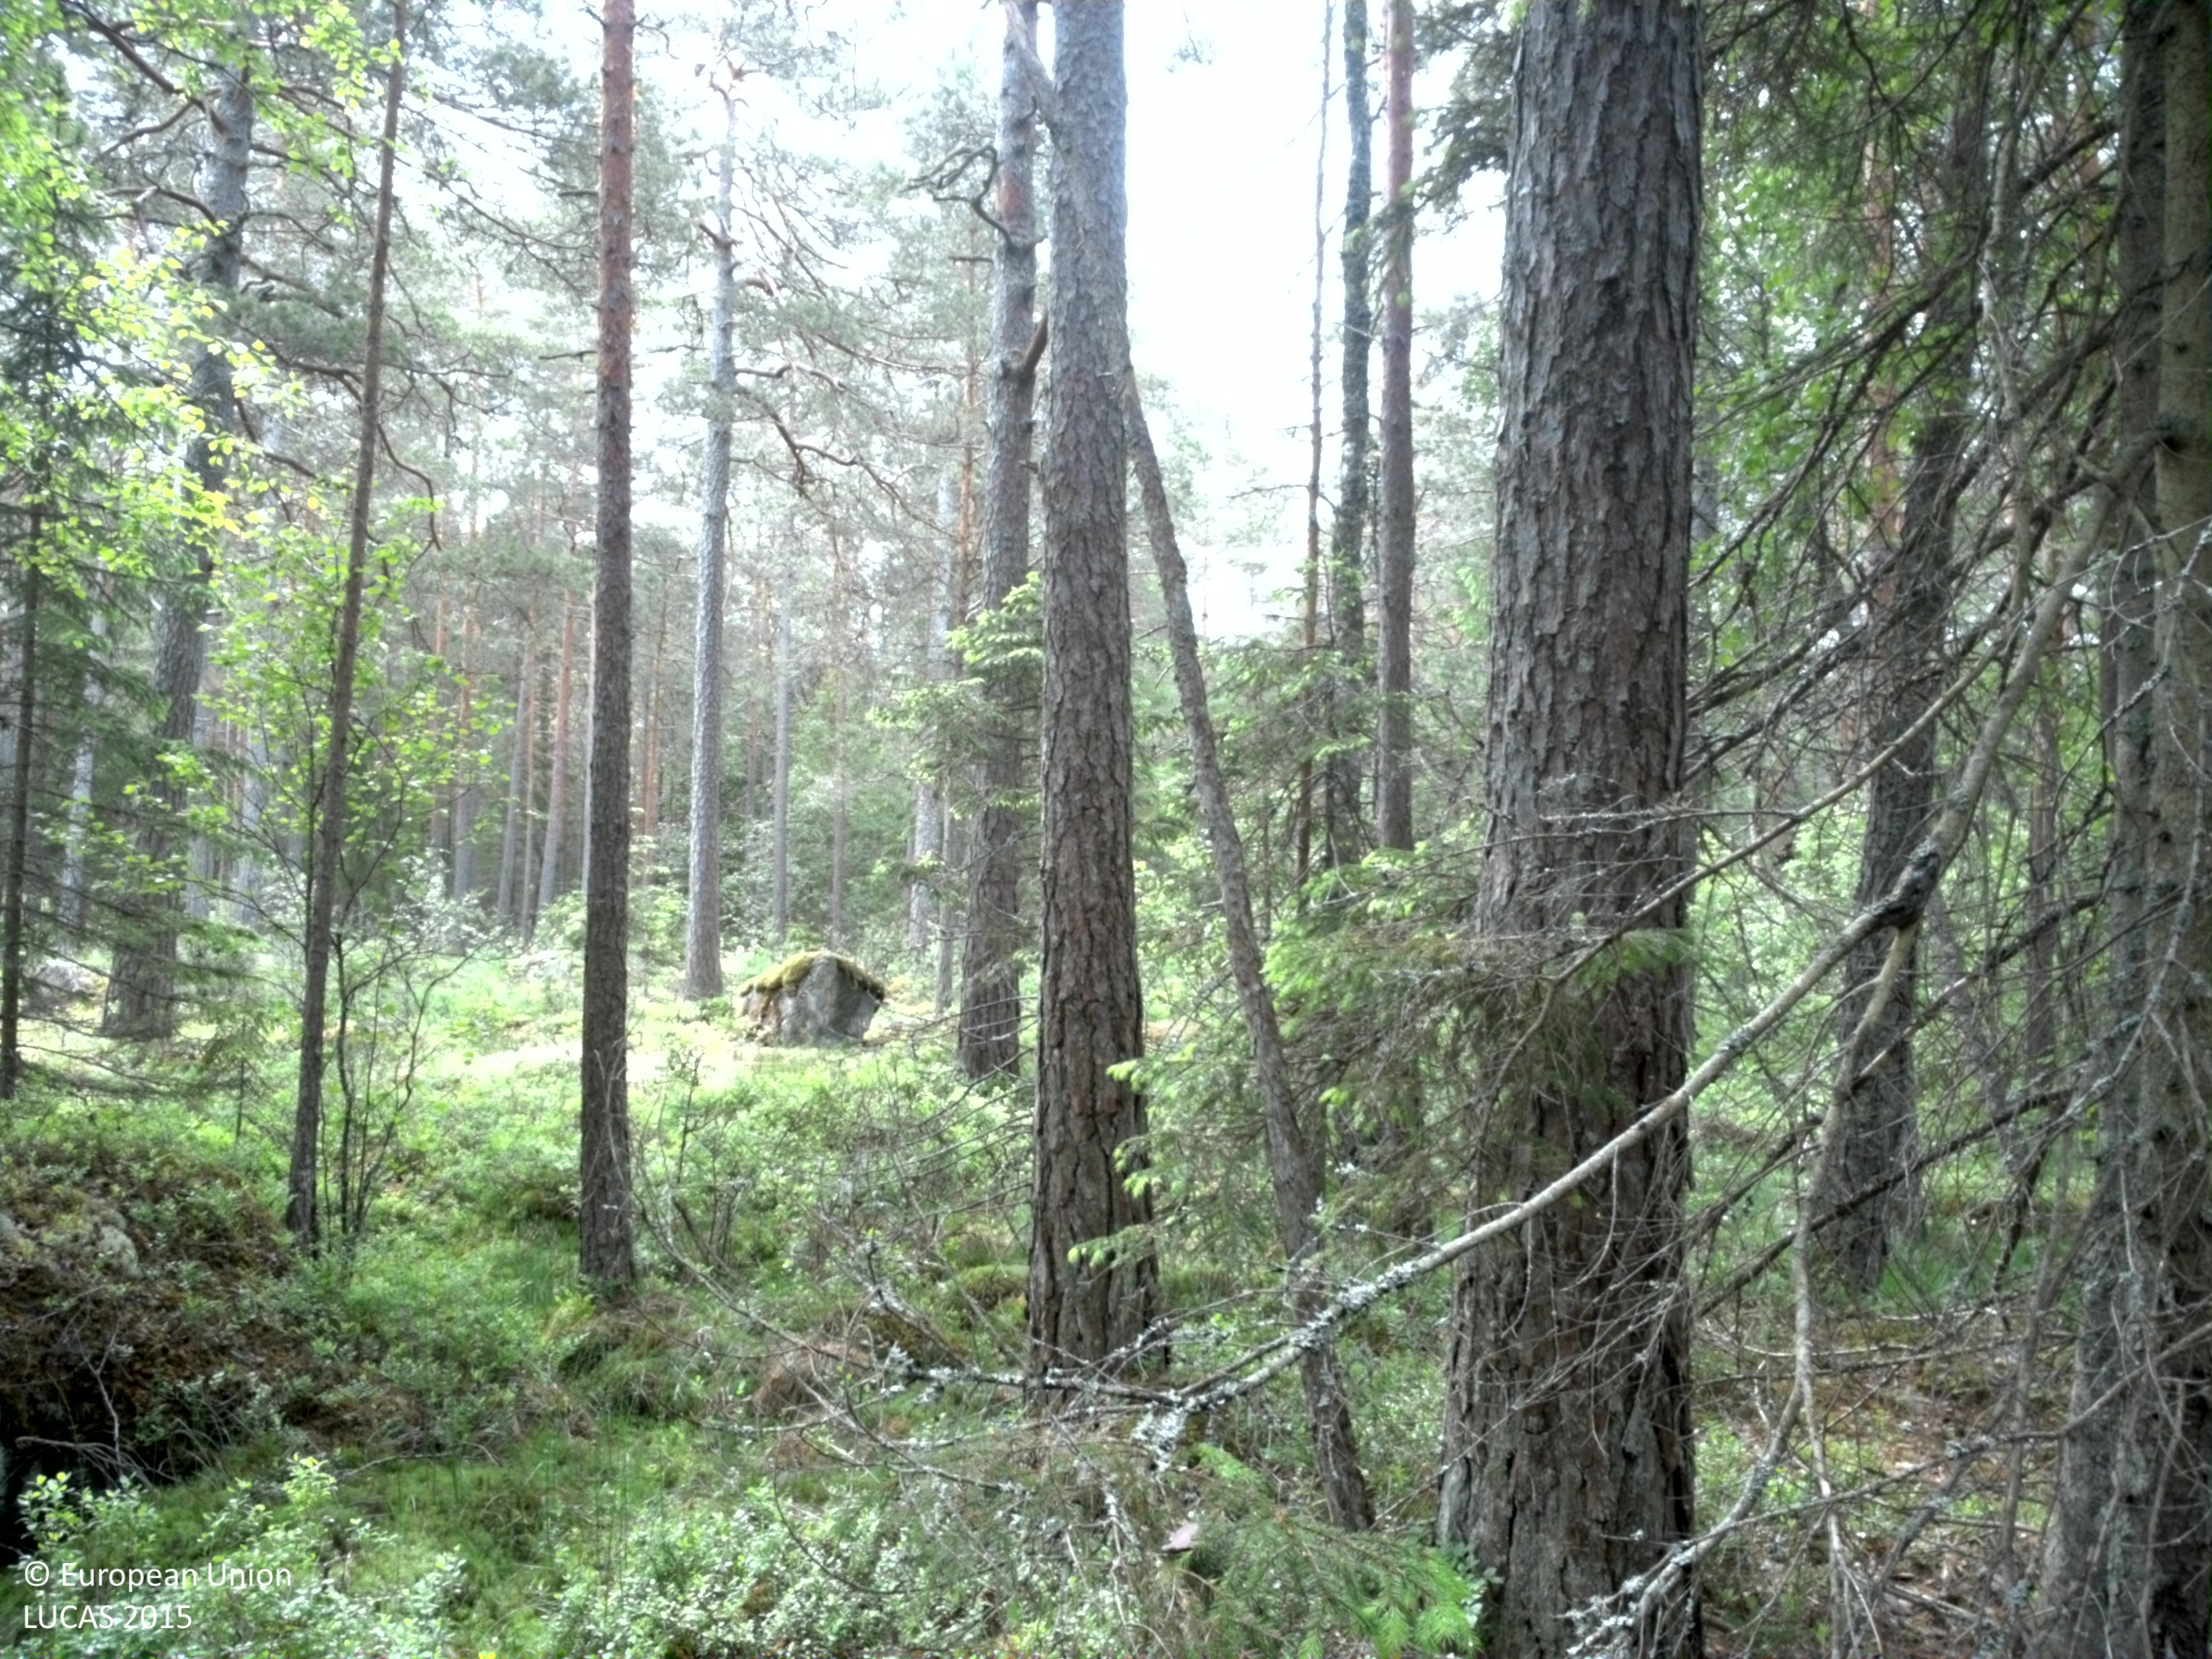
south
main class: Woodland
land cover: Pine dominated coniferous woodland
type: boreal forest
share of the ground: 50 - 75 %
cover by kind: coniferous forest trees 70 %, lichens and mosses 15 %, herbaceous plants 10 %, broadleaved forest trees 5 %
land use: Forestry
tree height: > 5 m
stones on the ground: < 10 %
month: June
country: SE
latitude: 59.6326
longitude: 16.8914
